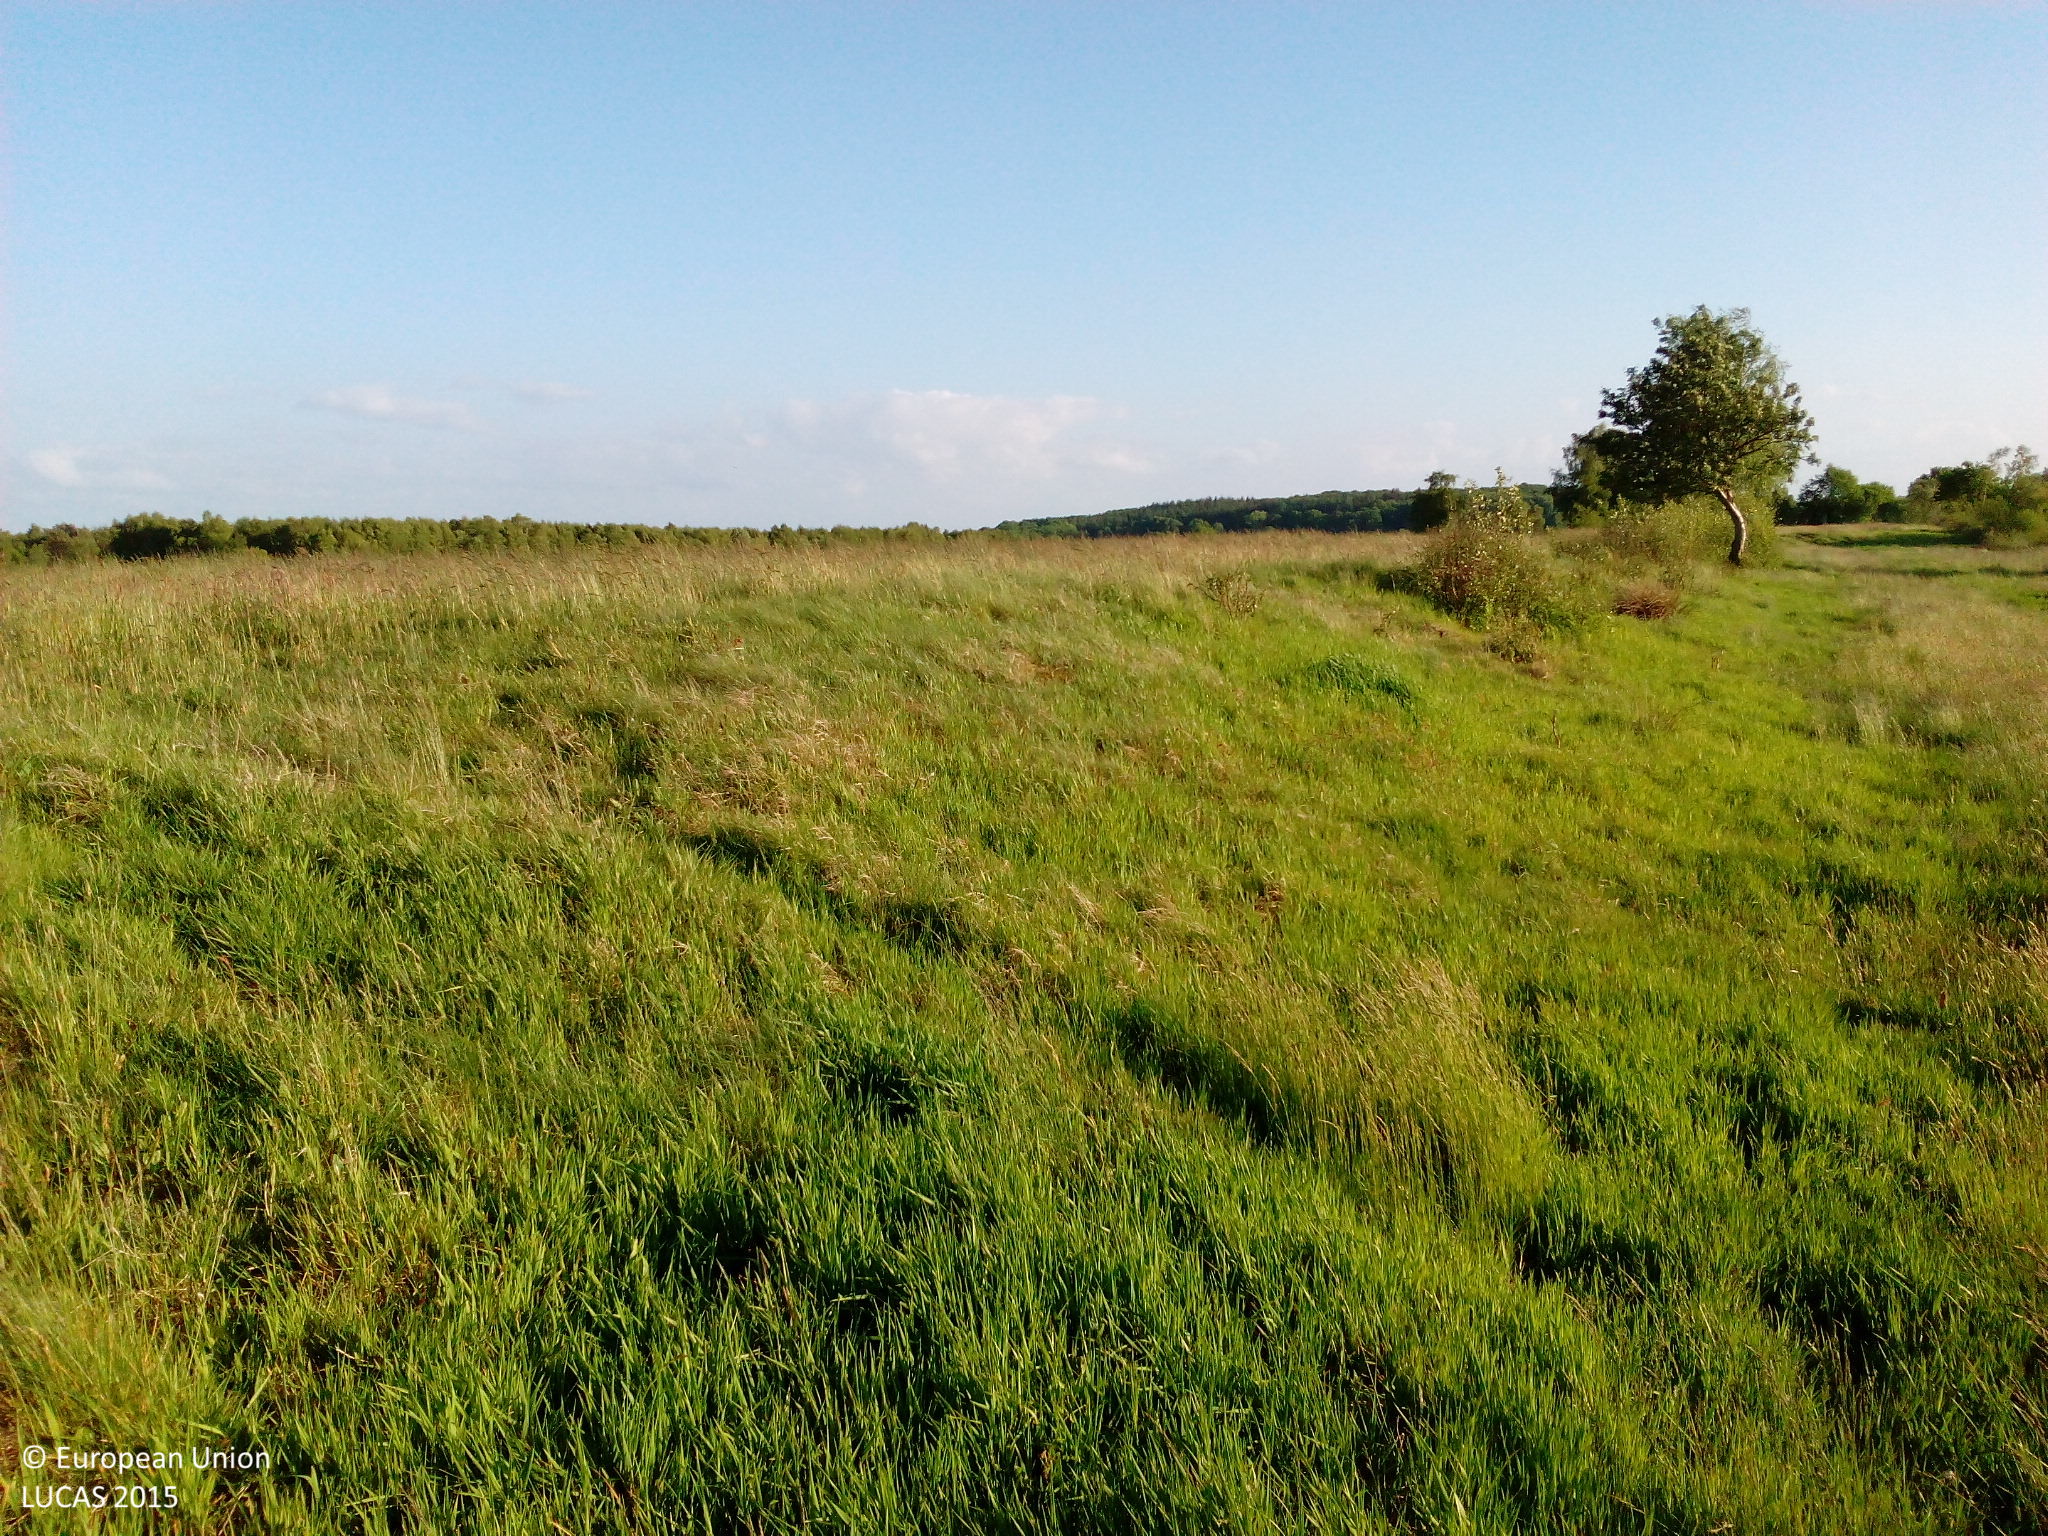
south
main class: Grassland
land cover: Grassland without tree/shrub cover
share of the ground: > 75 %
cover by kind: herbaceous plants 100 %
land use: Agriculture (excluding fallow land and kitchen gardens)
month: June
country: DE
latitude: 53.4883
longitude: 9.0811
